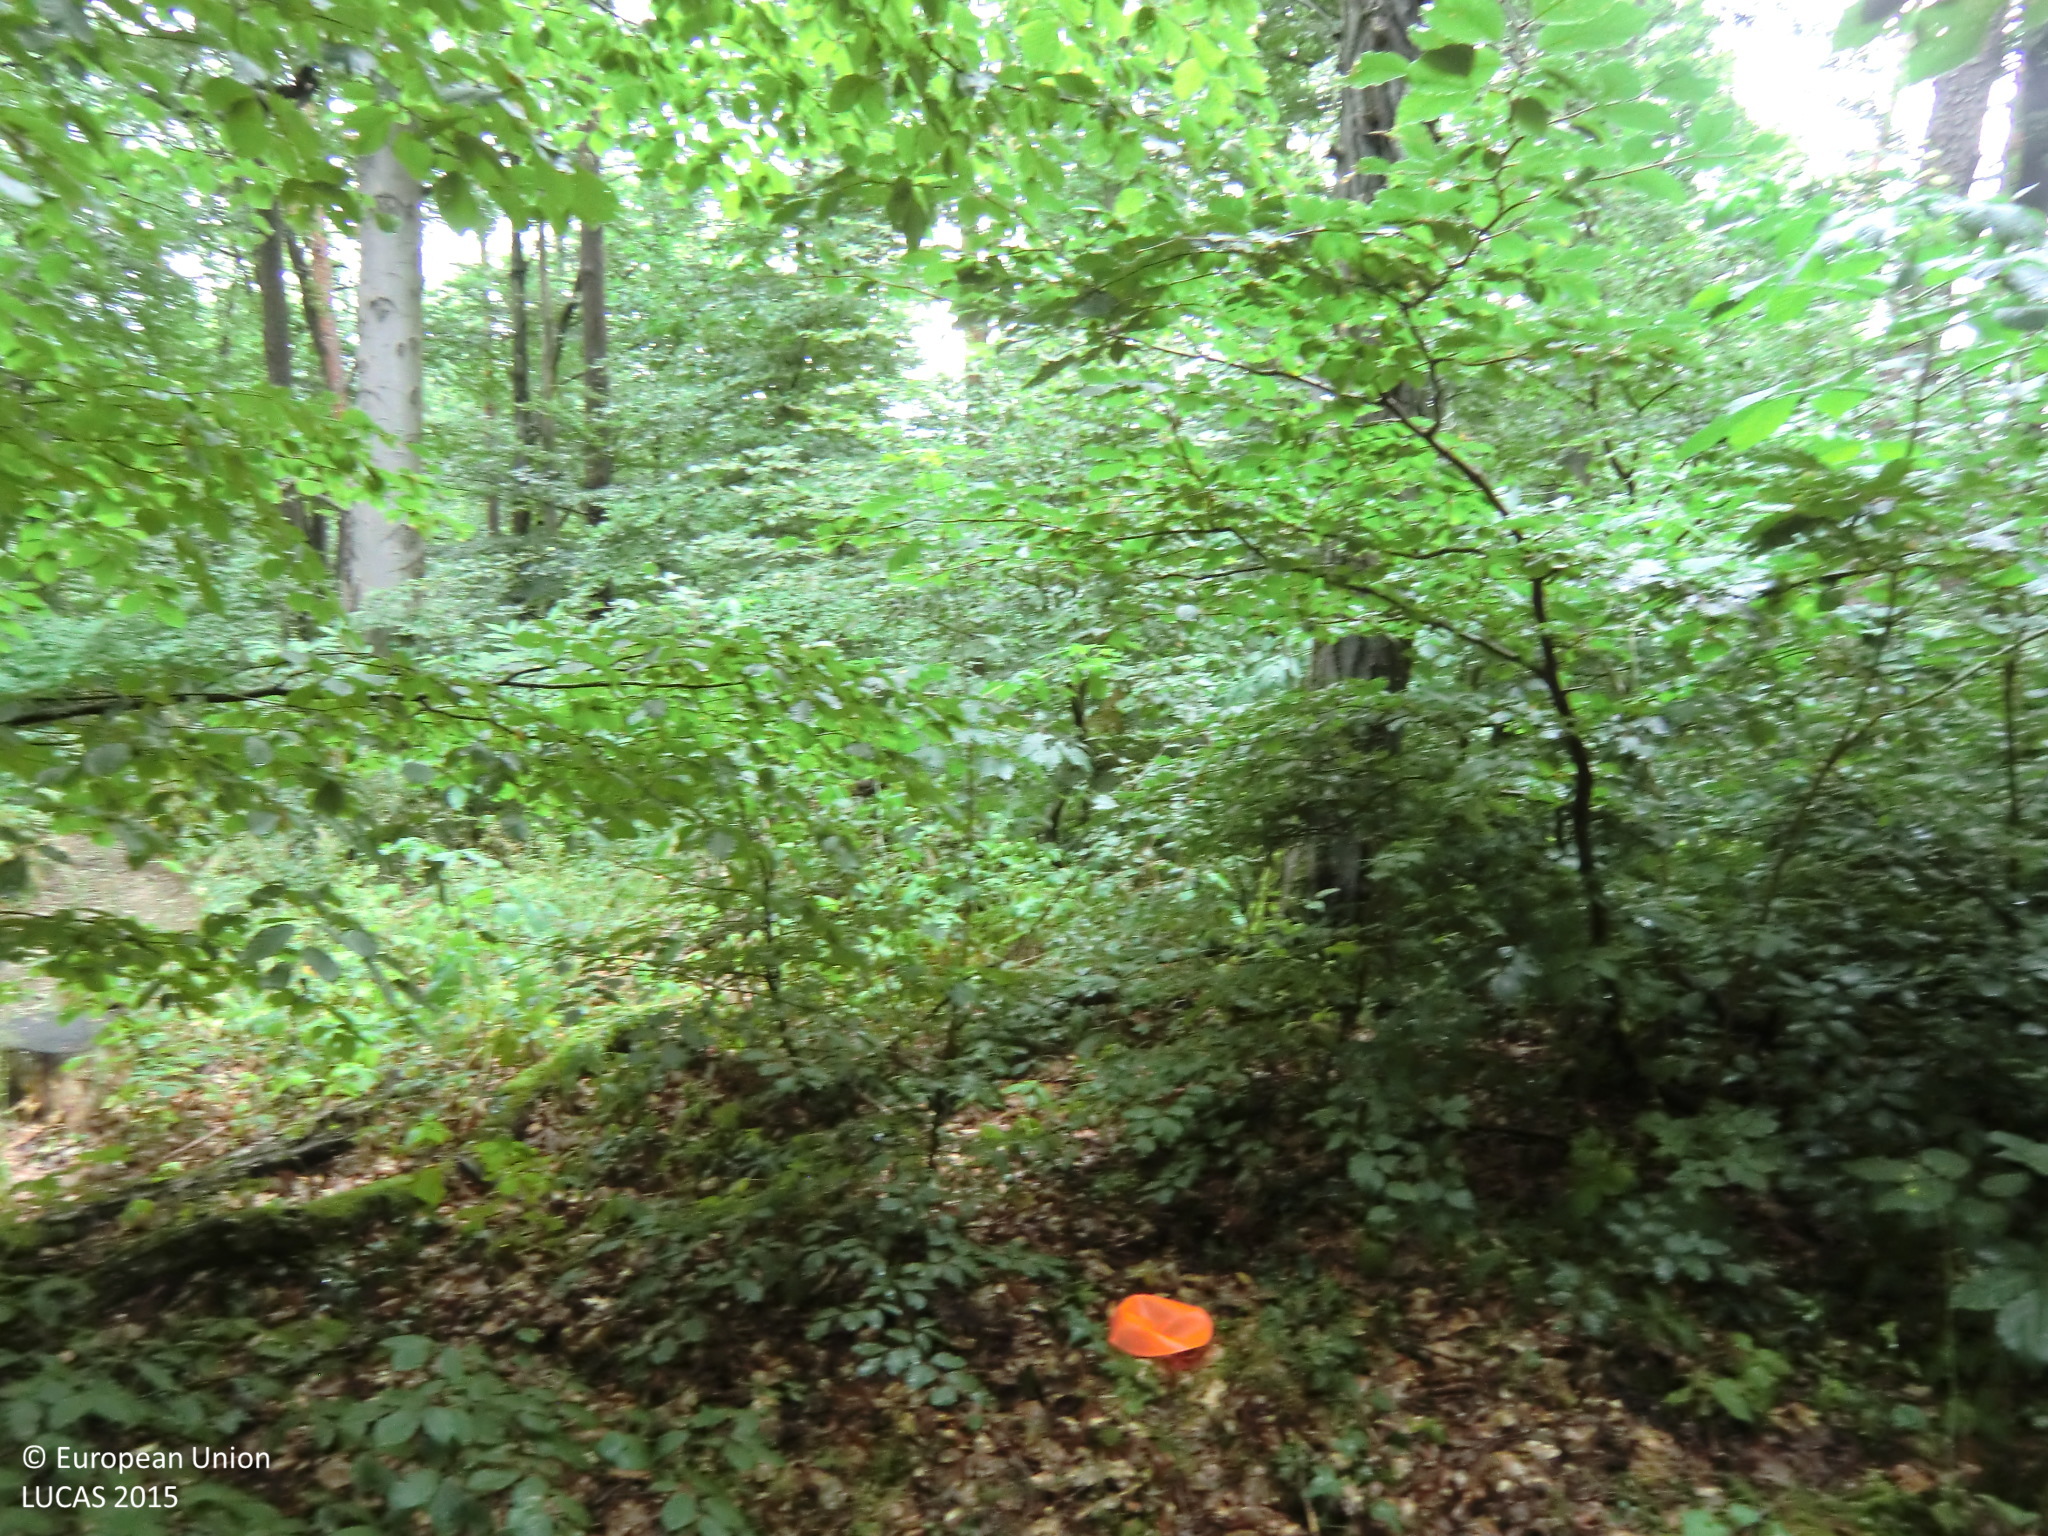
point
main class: Woodland
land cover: Pine dominated mixed woodland
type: hemiboreal forest and nemoral coniferous forest and mixed broadleaved-coniferous forest
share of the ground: 50 - 75 %
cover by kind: broadleaved forest trees 40 %, coniferous forest trees 30 %, shrubs 20 %, unconsolidated bare surface 10 %
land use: Forestry
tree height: > 5 m
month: July
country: AT
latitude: 47.1137
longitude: 15.4693
